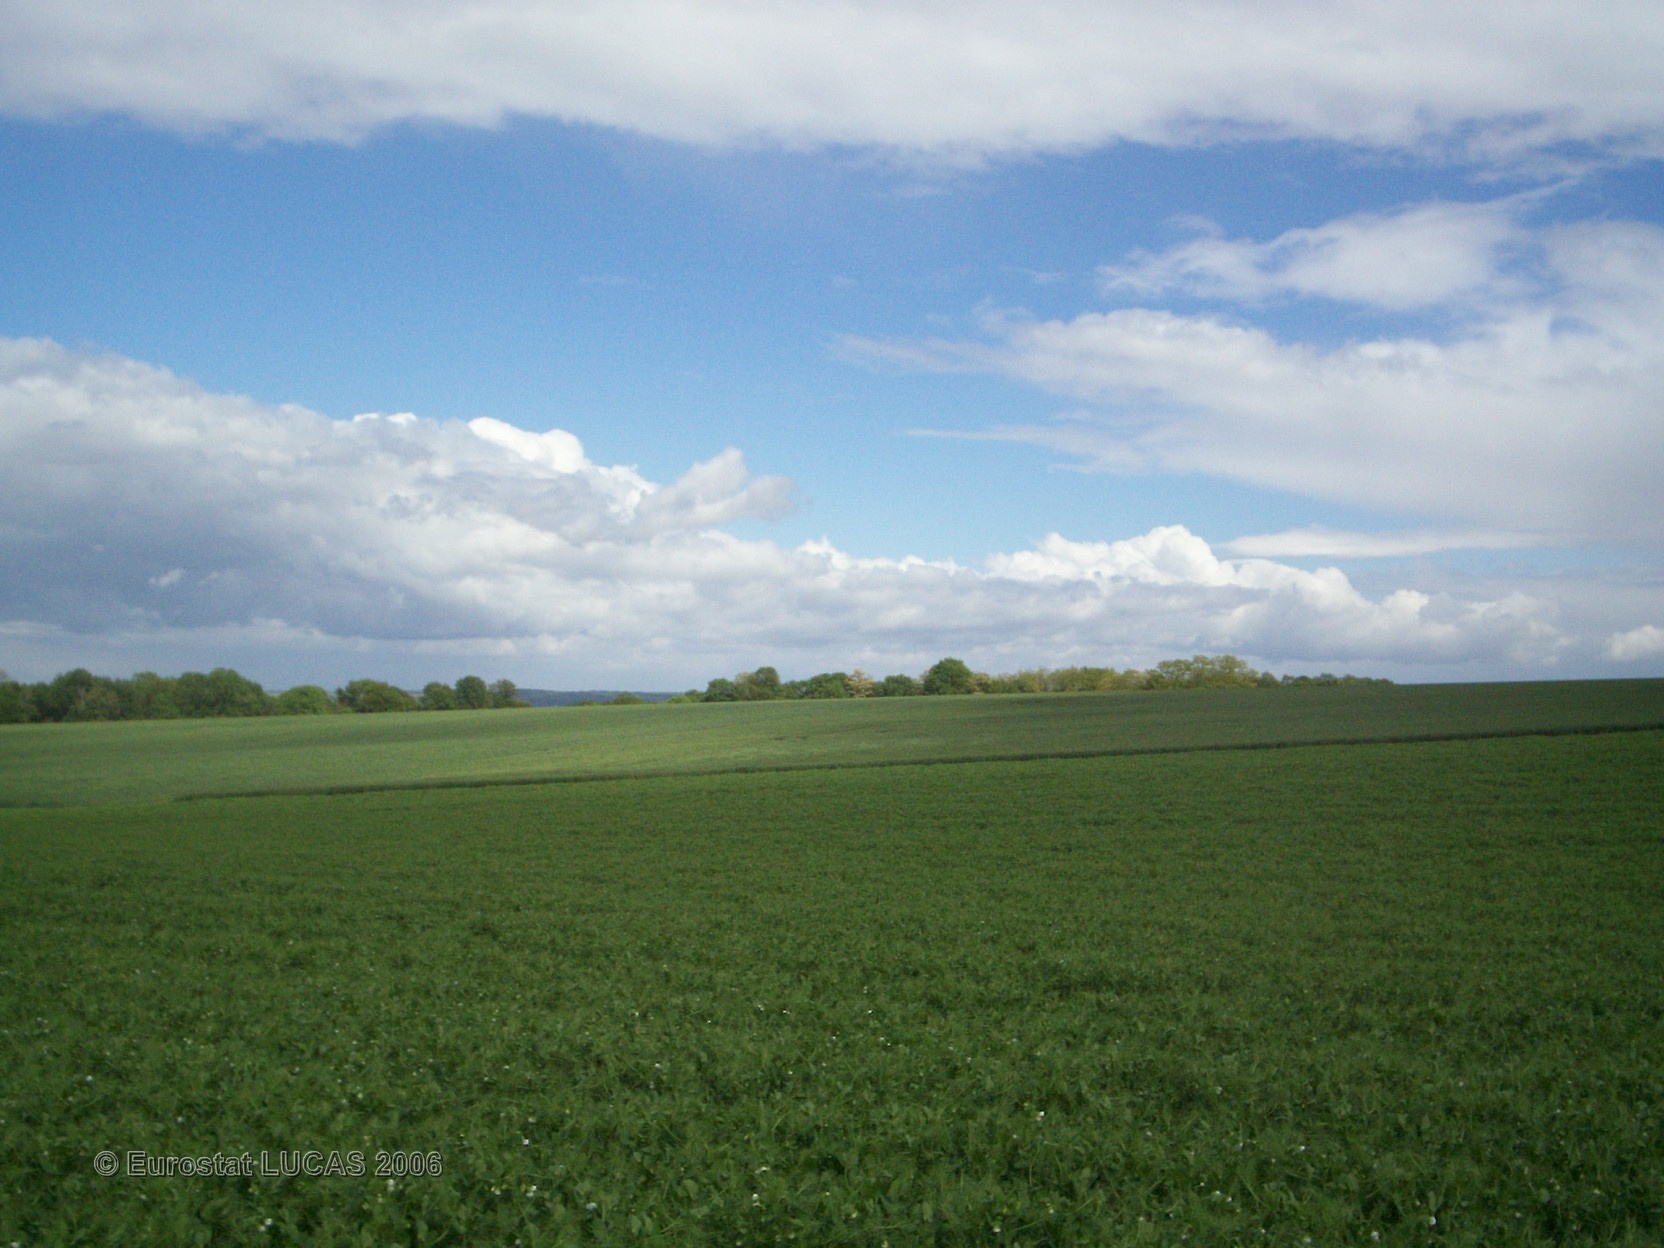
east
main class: Cropland
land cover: Dry pulses
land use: Agriculture (excluding fallow land and kitchen gardens)
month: May
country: FR
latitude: 49.1972
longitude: 2.7851
